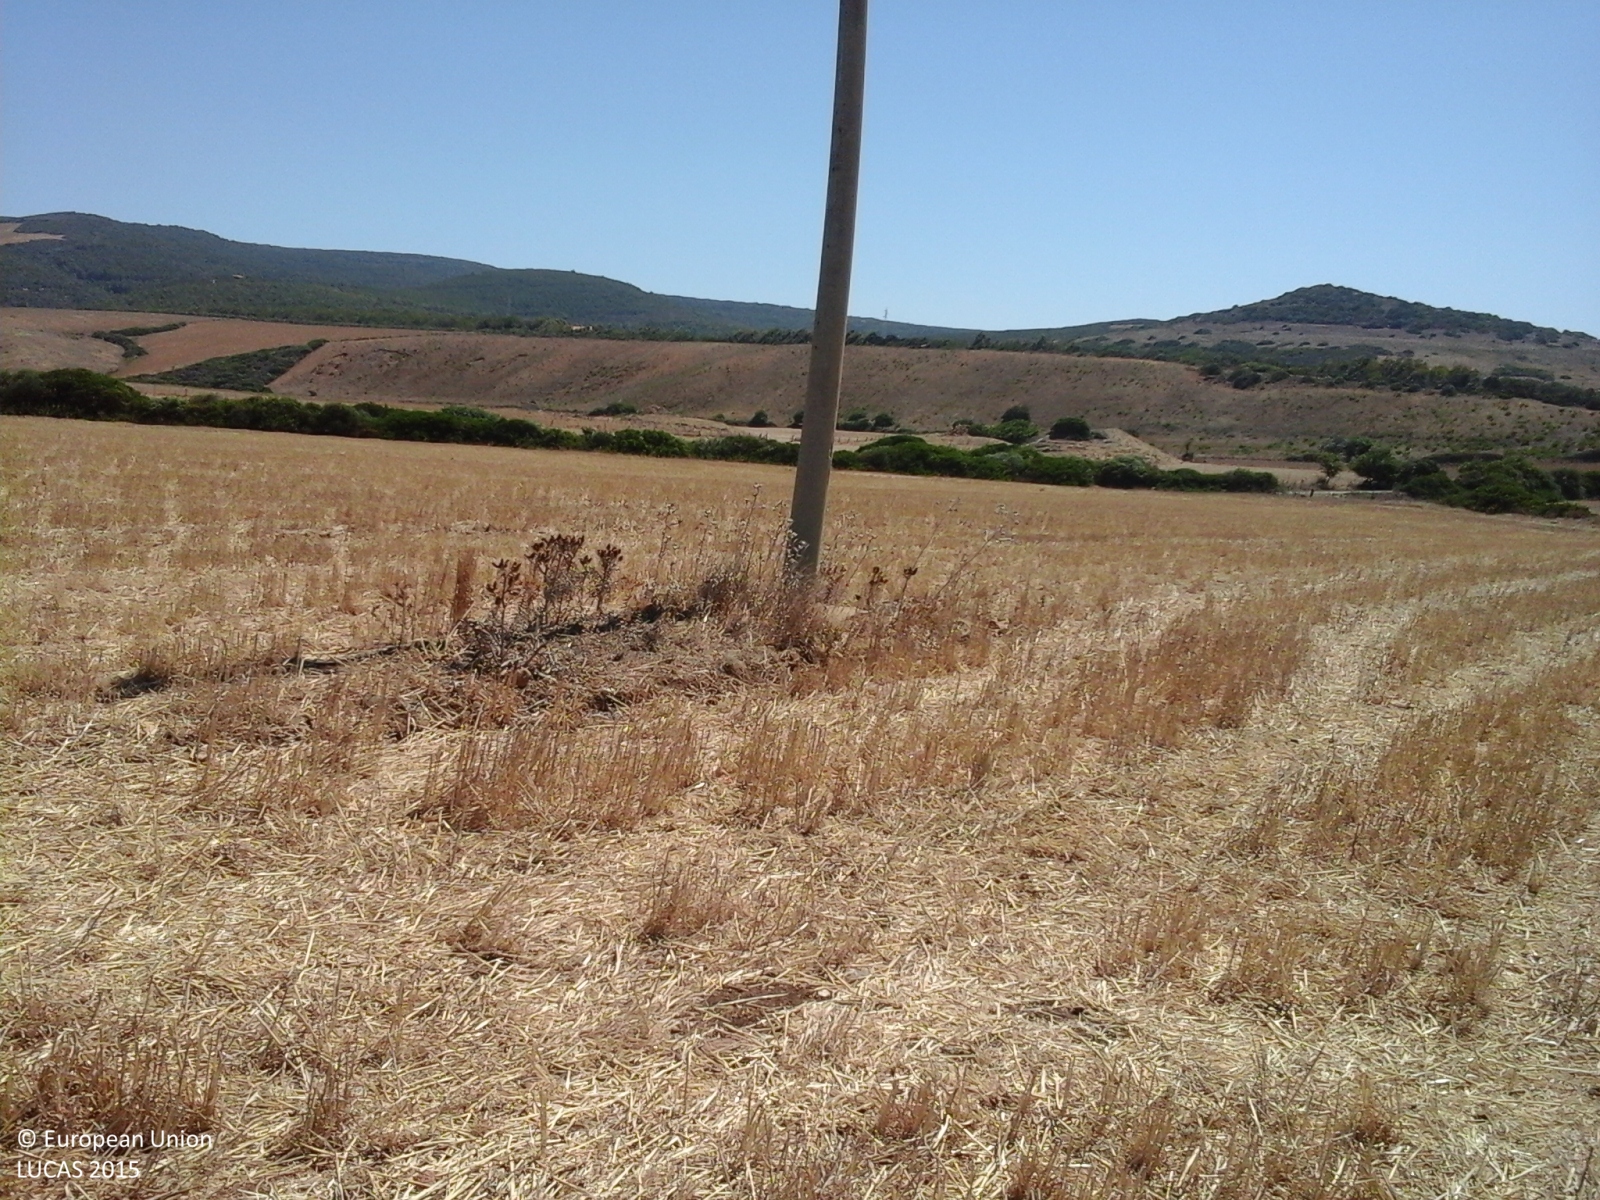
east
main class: Cropland
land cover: Durum wheat
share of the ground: > 75 %
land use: Agriculture (excluding fallow land and kitchen gardens)
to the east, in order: Durum wheat; Electric lines; Abandoned hedges; Fences; Grass margins; Tracks; Fences; Temporary grasslands; Fences
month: August
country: IT
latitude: 40.0570
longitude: 8.5192
